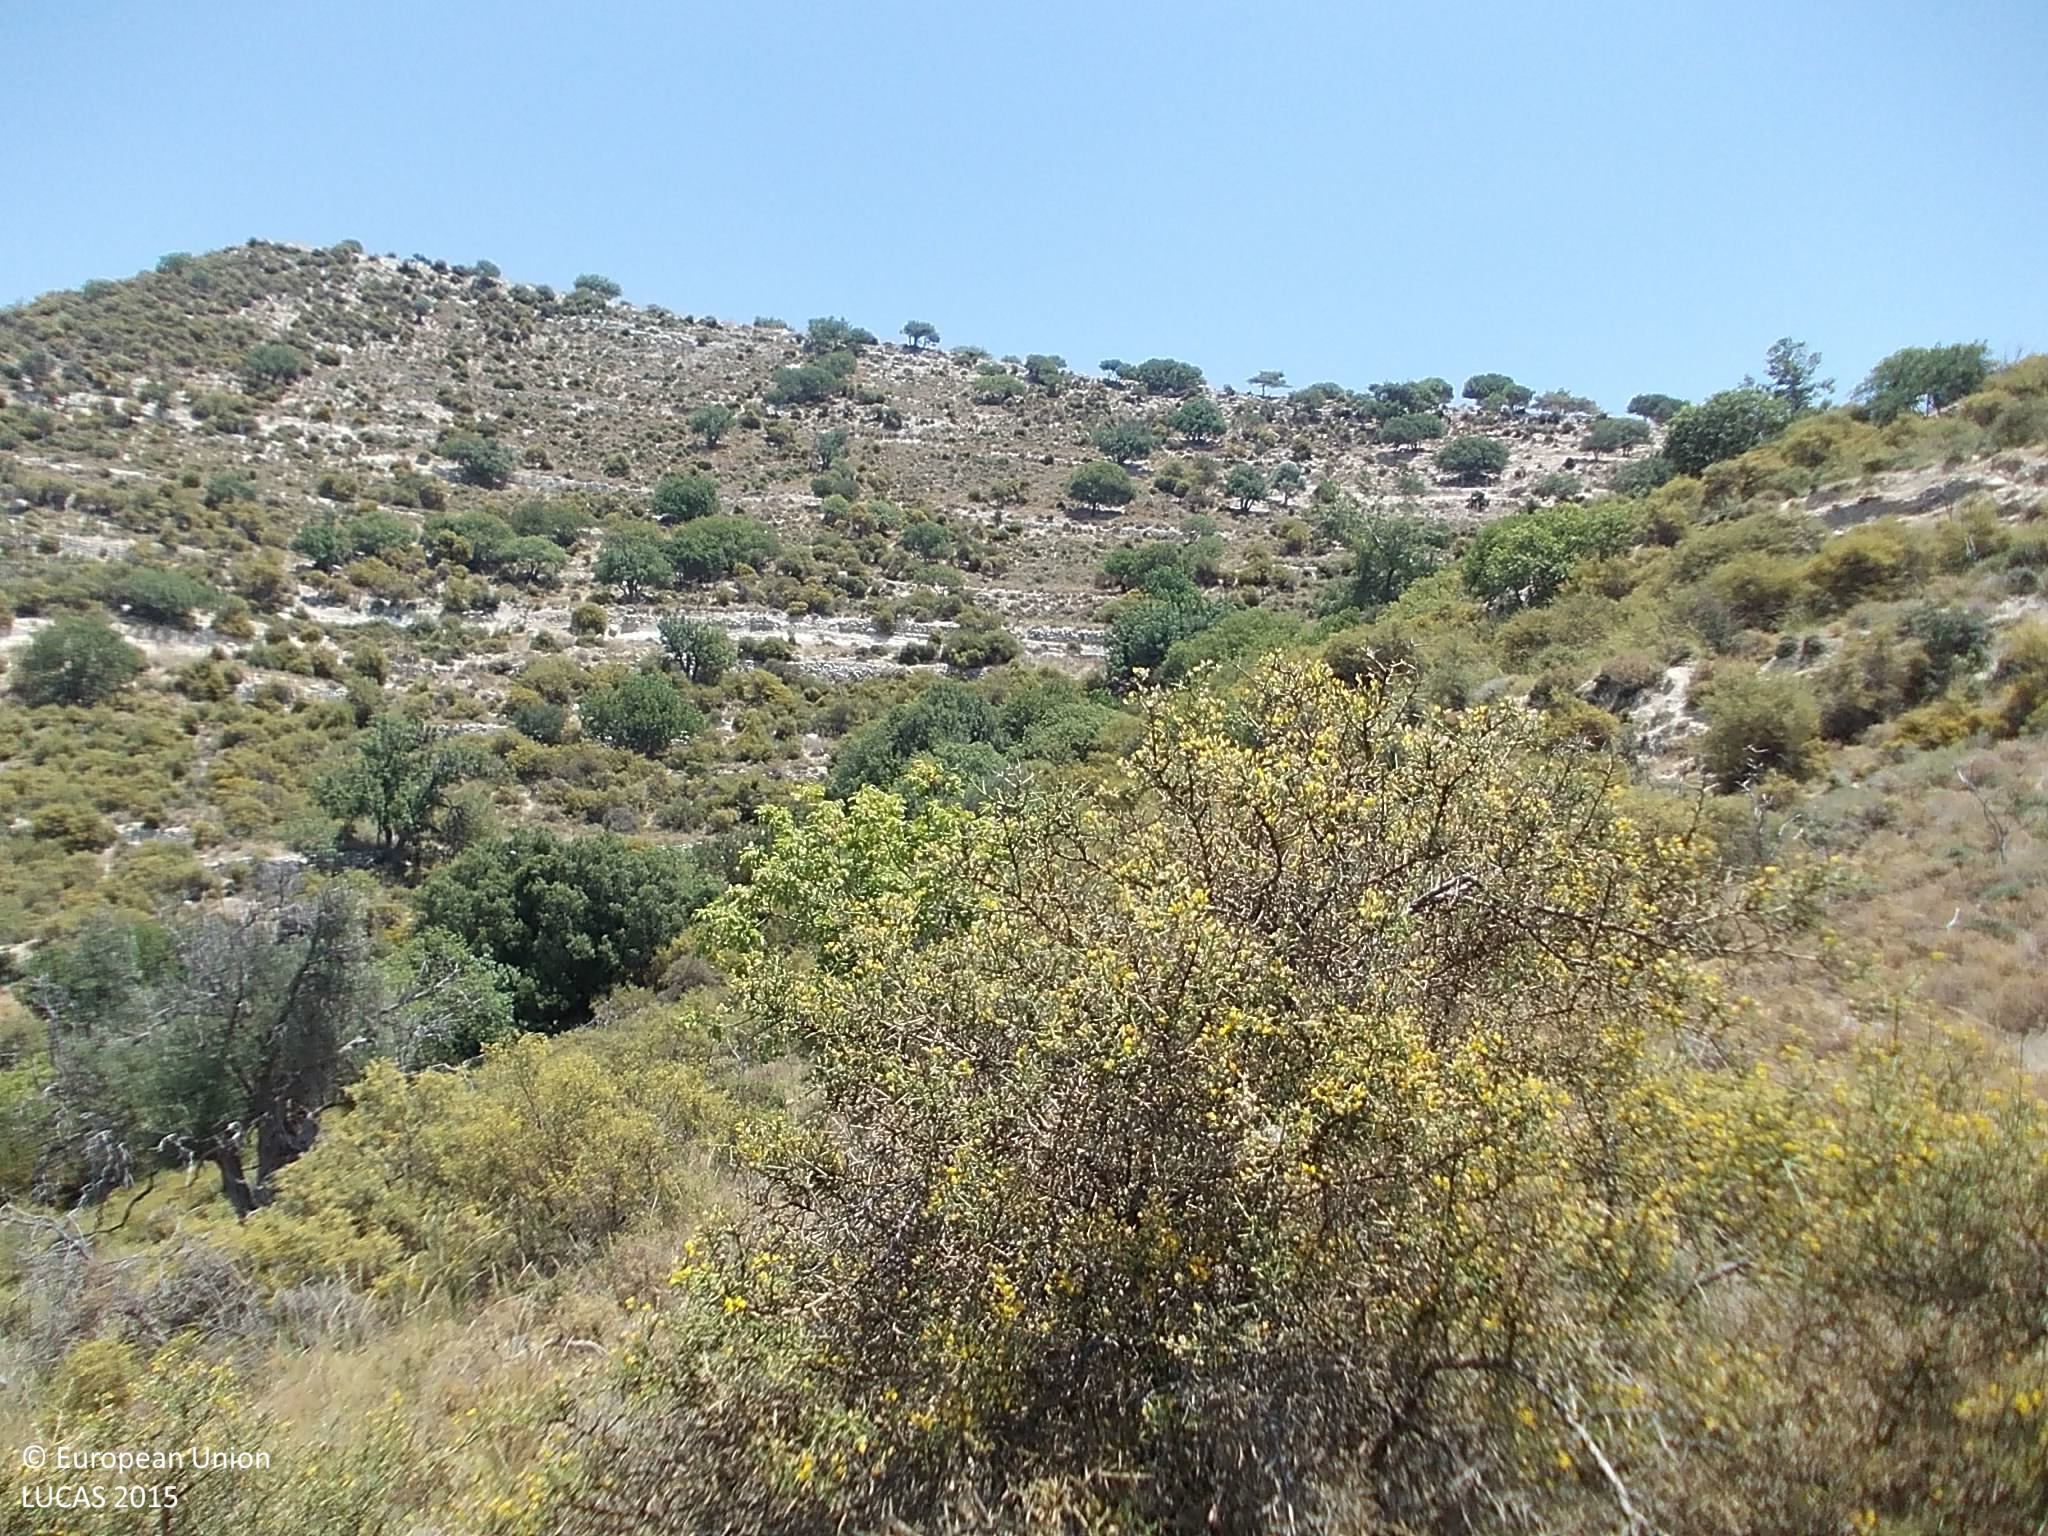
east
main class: Shrubland
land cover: Shrubland with sparse tree cover
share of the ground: 50 - 75 %
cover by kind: shrubs 65 %, herbaceous plants 15 %, unconsolidated bare surface 15 %, broadleaved forest trees 5 %
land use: Semi-natural and natural areas not in use
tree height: > 5 m
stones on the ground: 25 - 50 %
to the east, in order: Shrubland with sparse tree cover; Rivers and streams; Pine dominated mixed woodland; Shrubland with sparse tree cover; Tracks; Broadleaved woodland; Shrubland with sparse tree cover
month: July
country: CY
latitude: 34.7370
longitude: 32.7077
